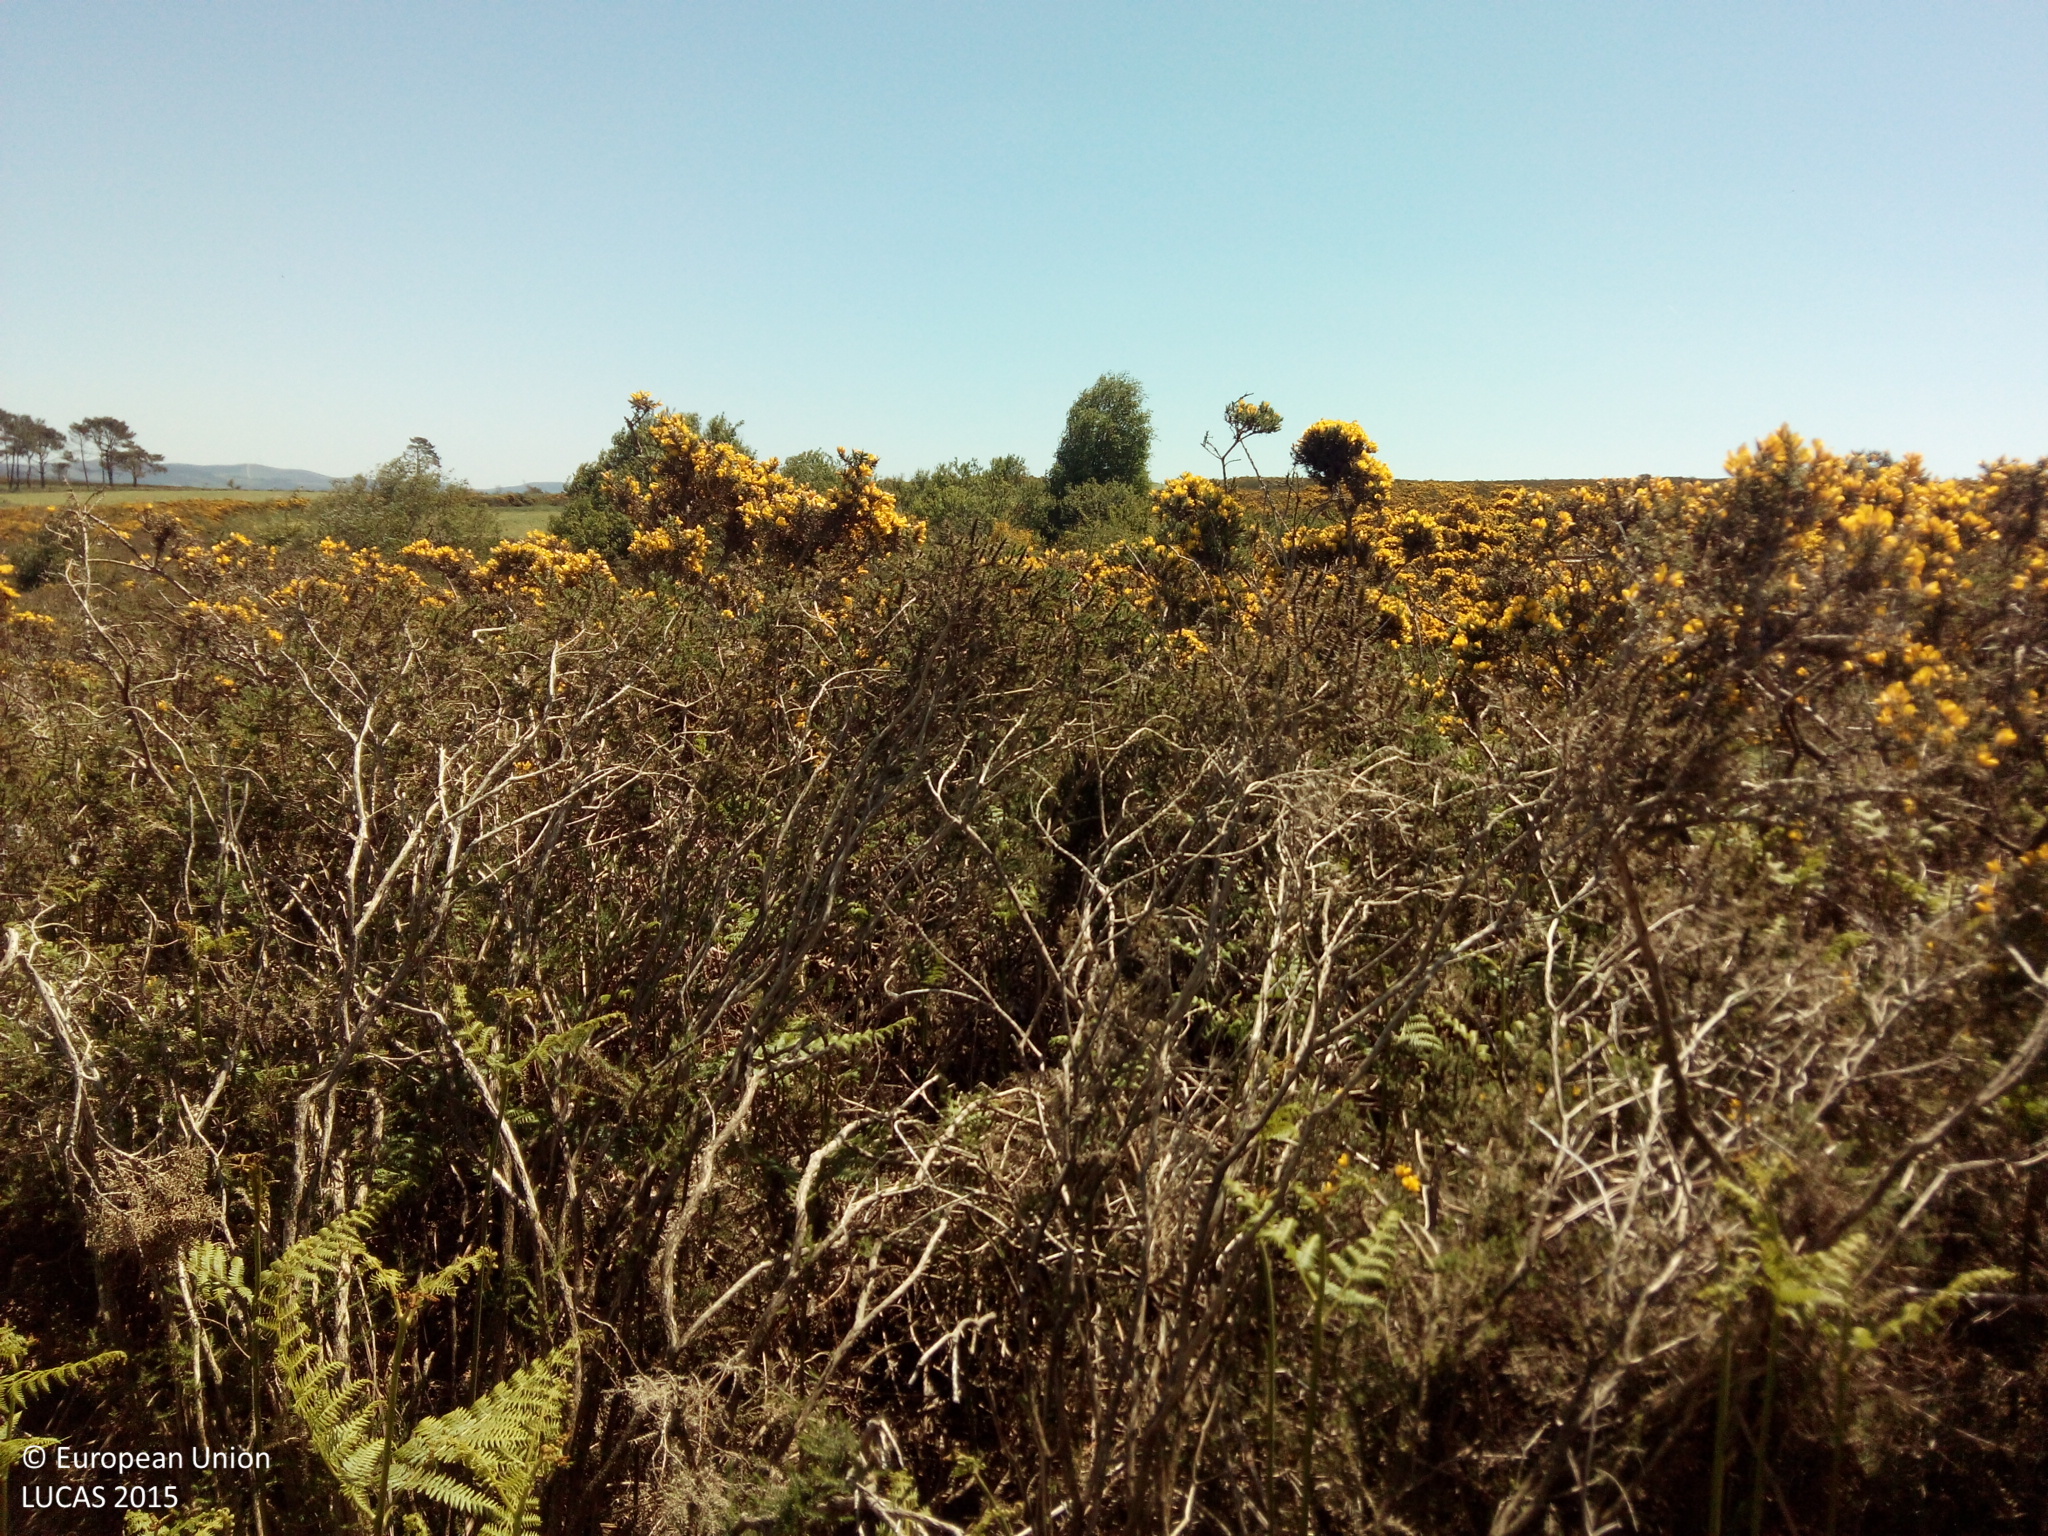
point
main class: Shrubland
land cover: Shrubland without tree cover
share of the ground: > 75 %
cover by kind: shrubs 100 %
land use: Abandoned areas
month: May
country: ES
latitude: 42.6234
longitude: -8.3474
